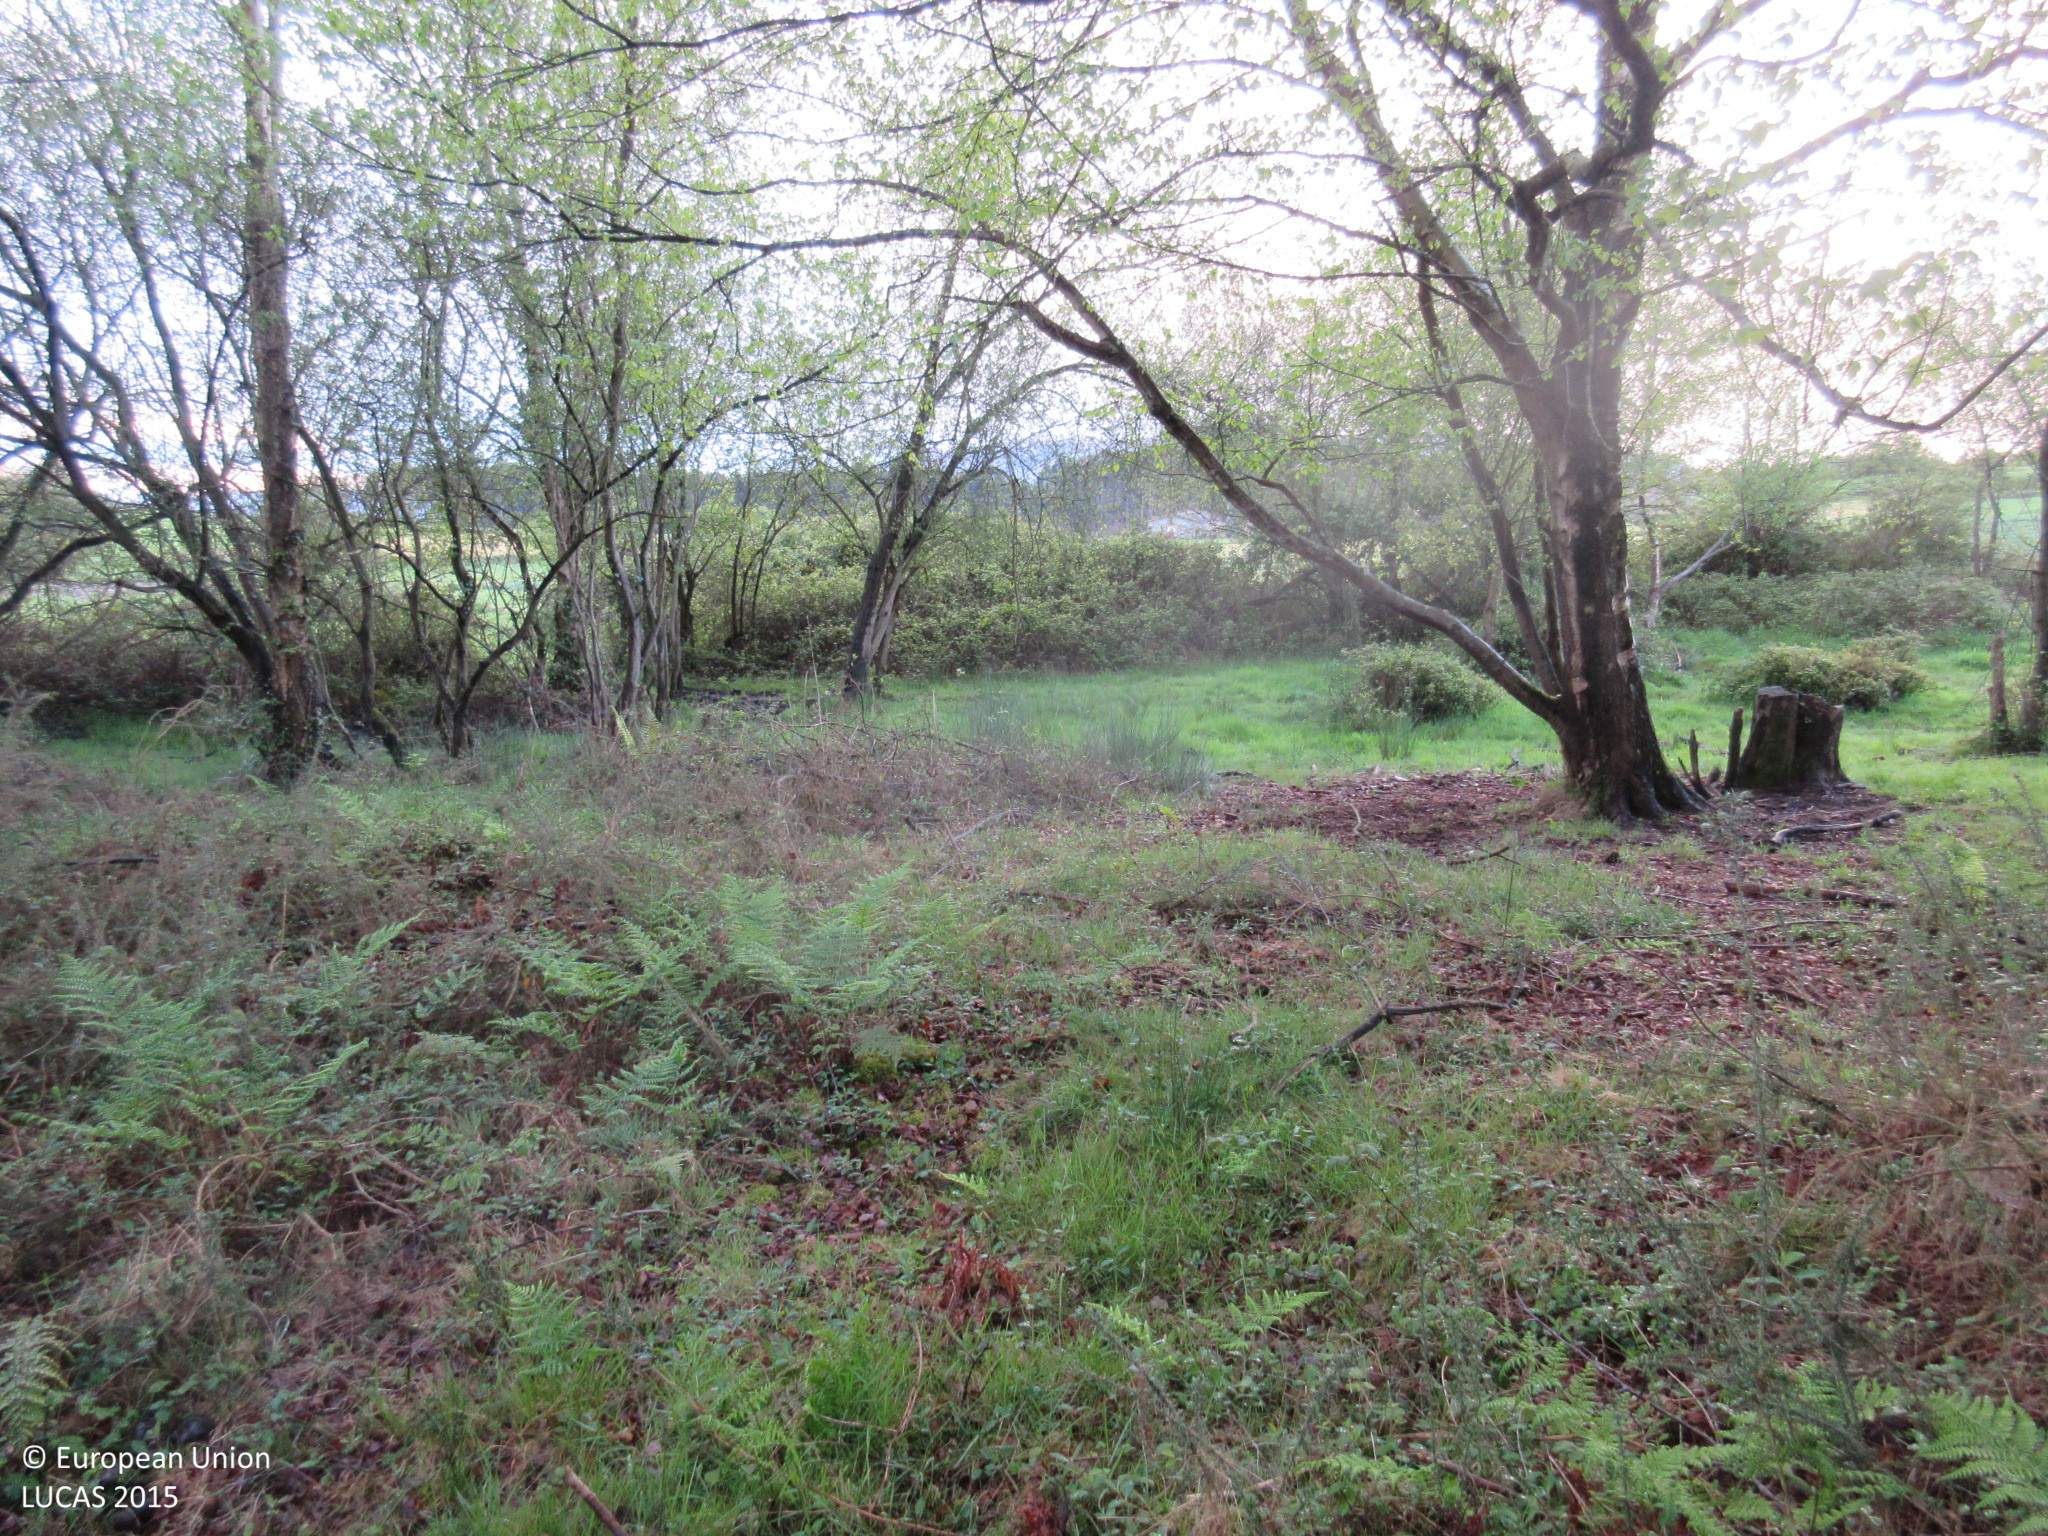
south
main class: Woodland
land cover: Broadleaved woodland
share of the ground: > 75 %
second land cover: Shrubland without tree cover
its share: 10 - 25 %
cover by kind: broadleaved forest trees 80 %, shrubs 10 %, herbaceous plants 10 %
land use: Forestry
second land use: Agriculture (excluding fallow land and kitchen gardens)
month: April
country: ES
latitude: 43.5186
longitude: -5.3067
